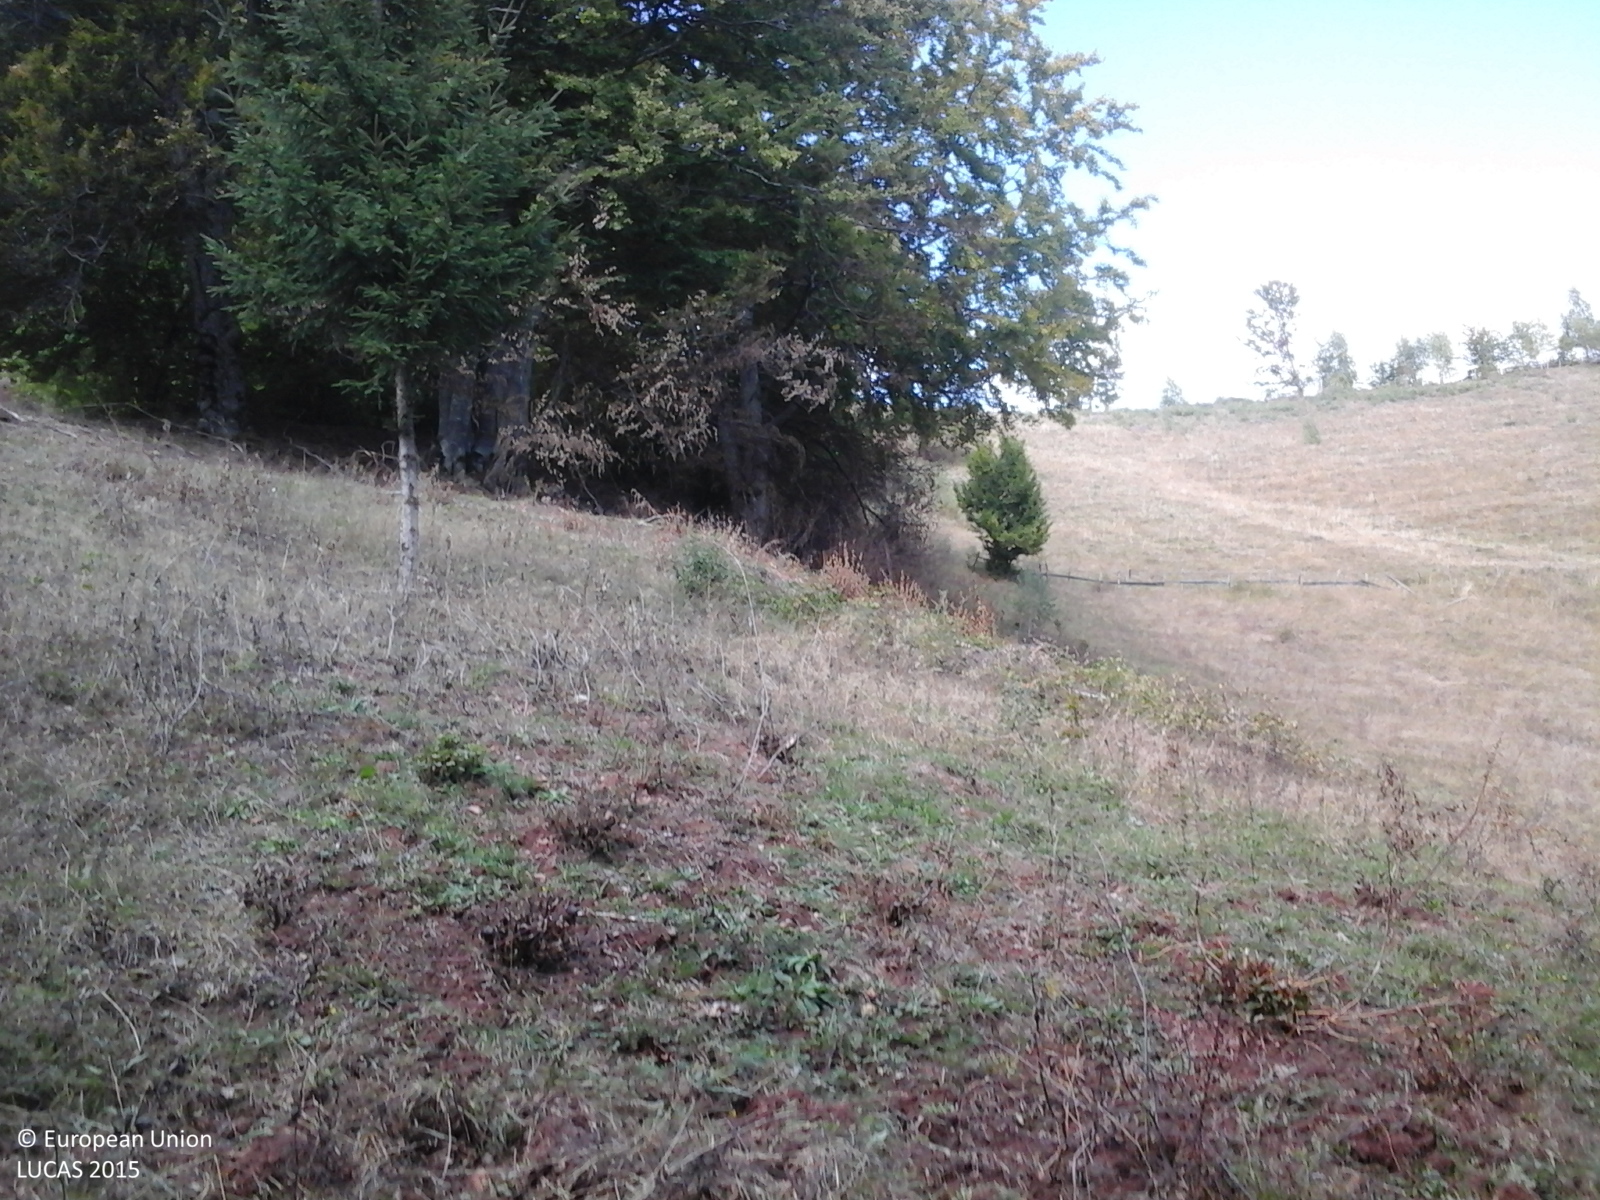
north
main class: Woodland
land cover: Broadleaved woodland
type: mesophytic deciduous forest
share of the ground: > 75 %
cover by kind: broadleaved forest trees 100 %
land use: Forestry
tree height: > 5 m
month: October
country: RO
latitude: 46.3876
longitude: 22.8913
